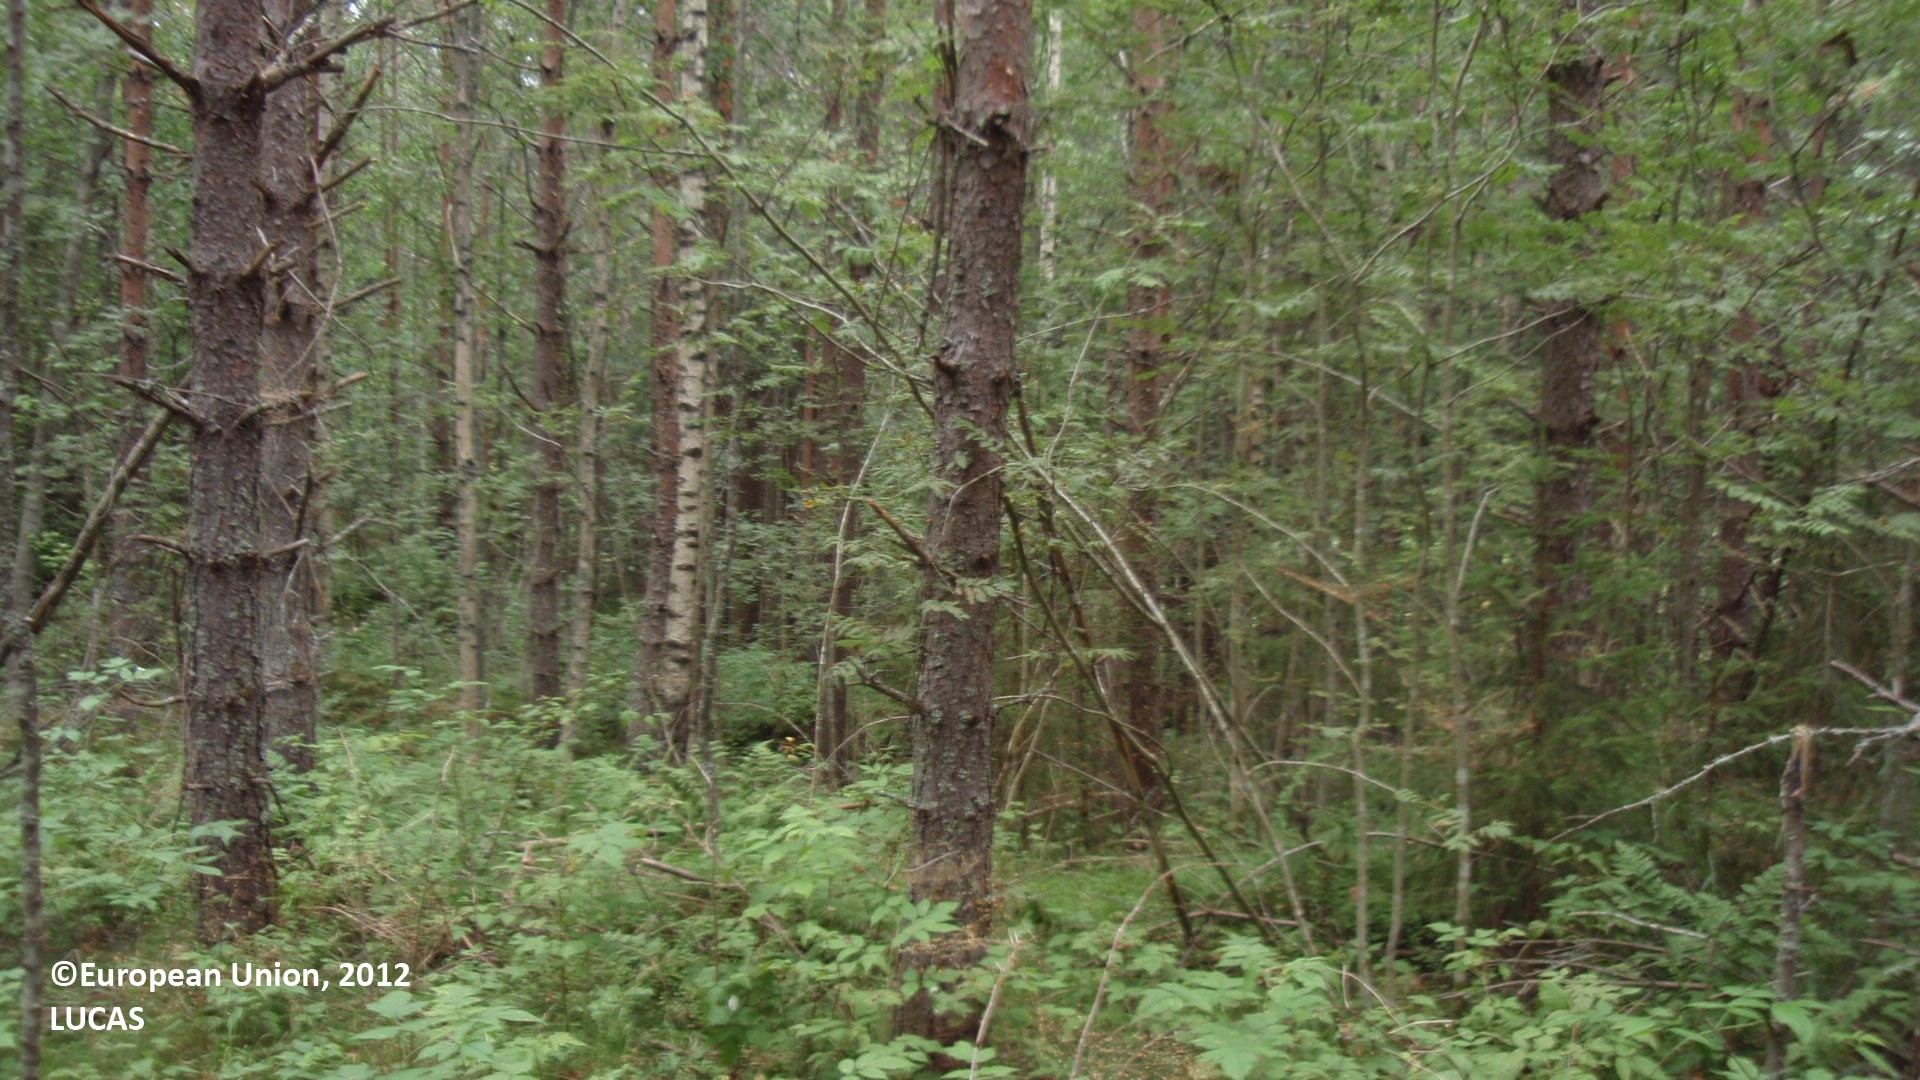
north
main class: Woodland
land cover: Pine dominated mixed woodland
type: boreal forest
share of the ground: > 75 %
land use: Forestry
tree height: > 5 m
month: August
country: FI
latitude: 61.0890
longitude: 27.6729
